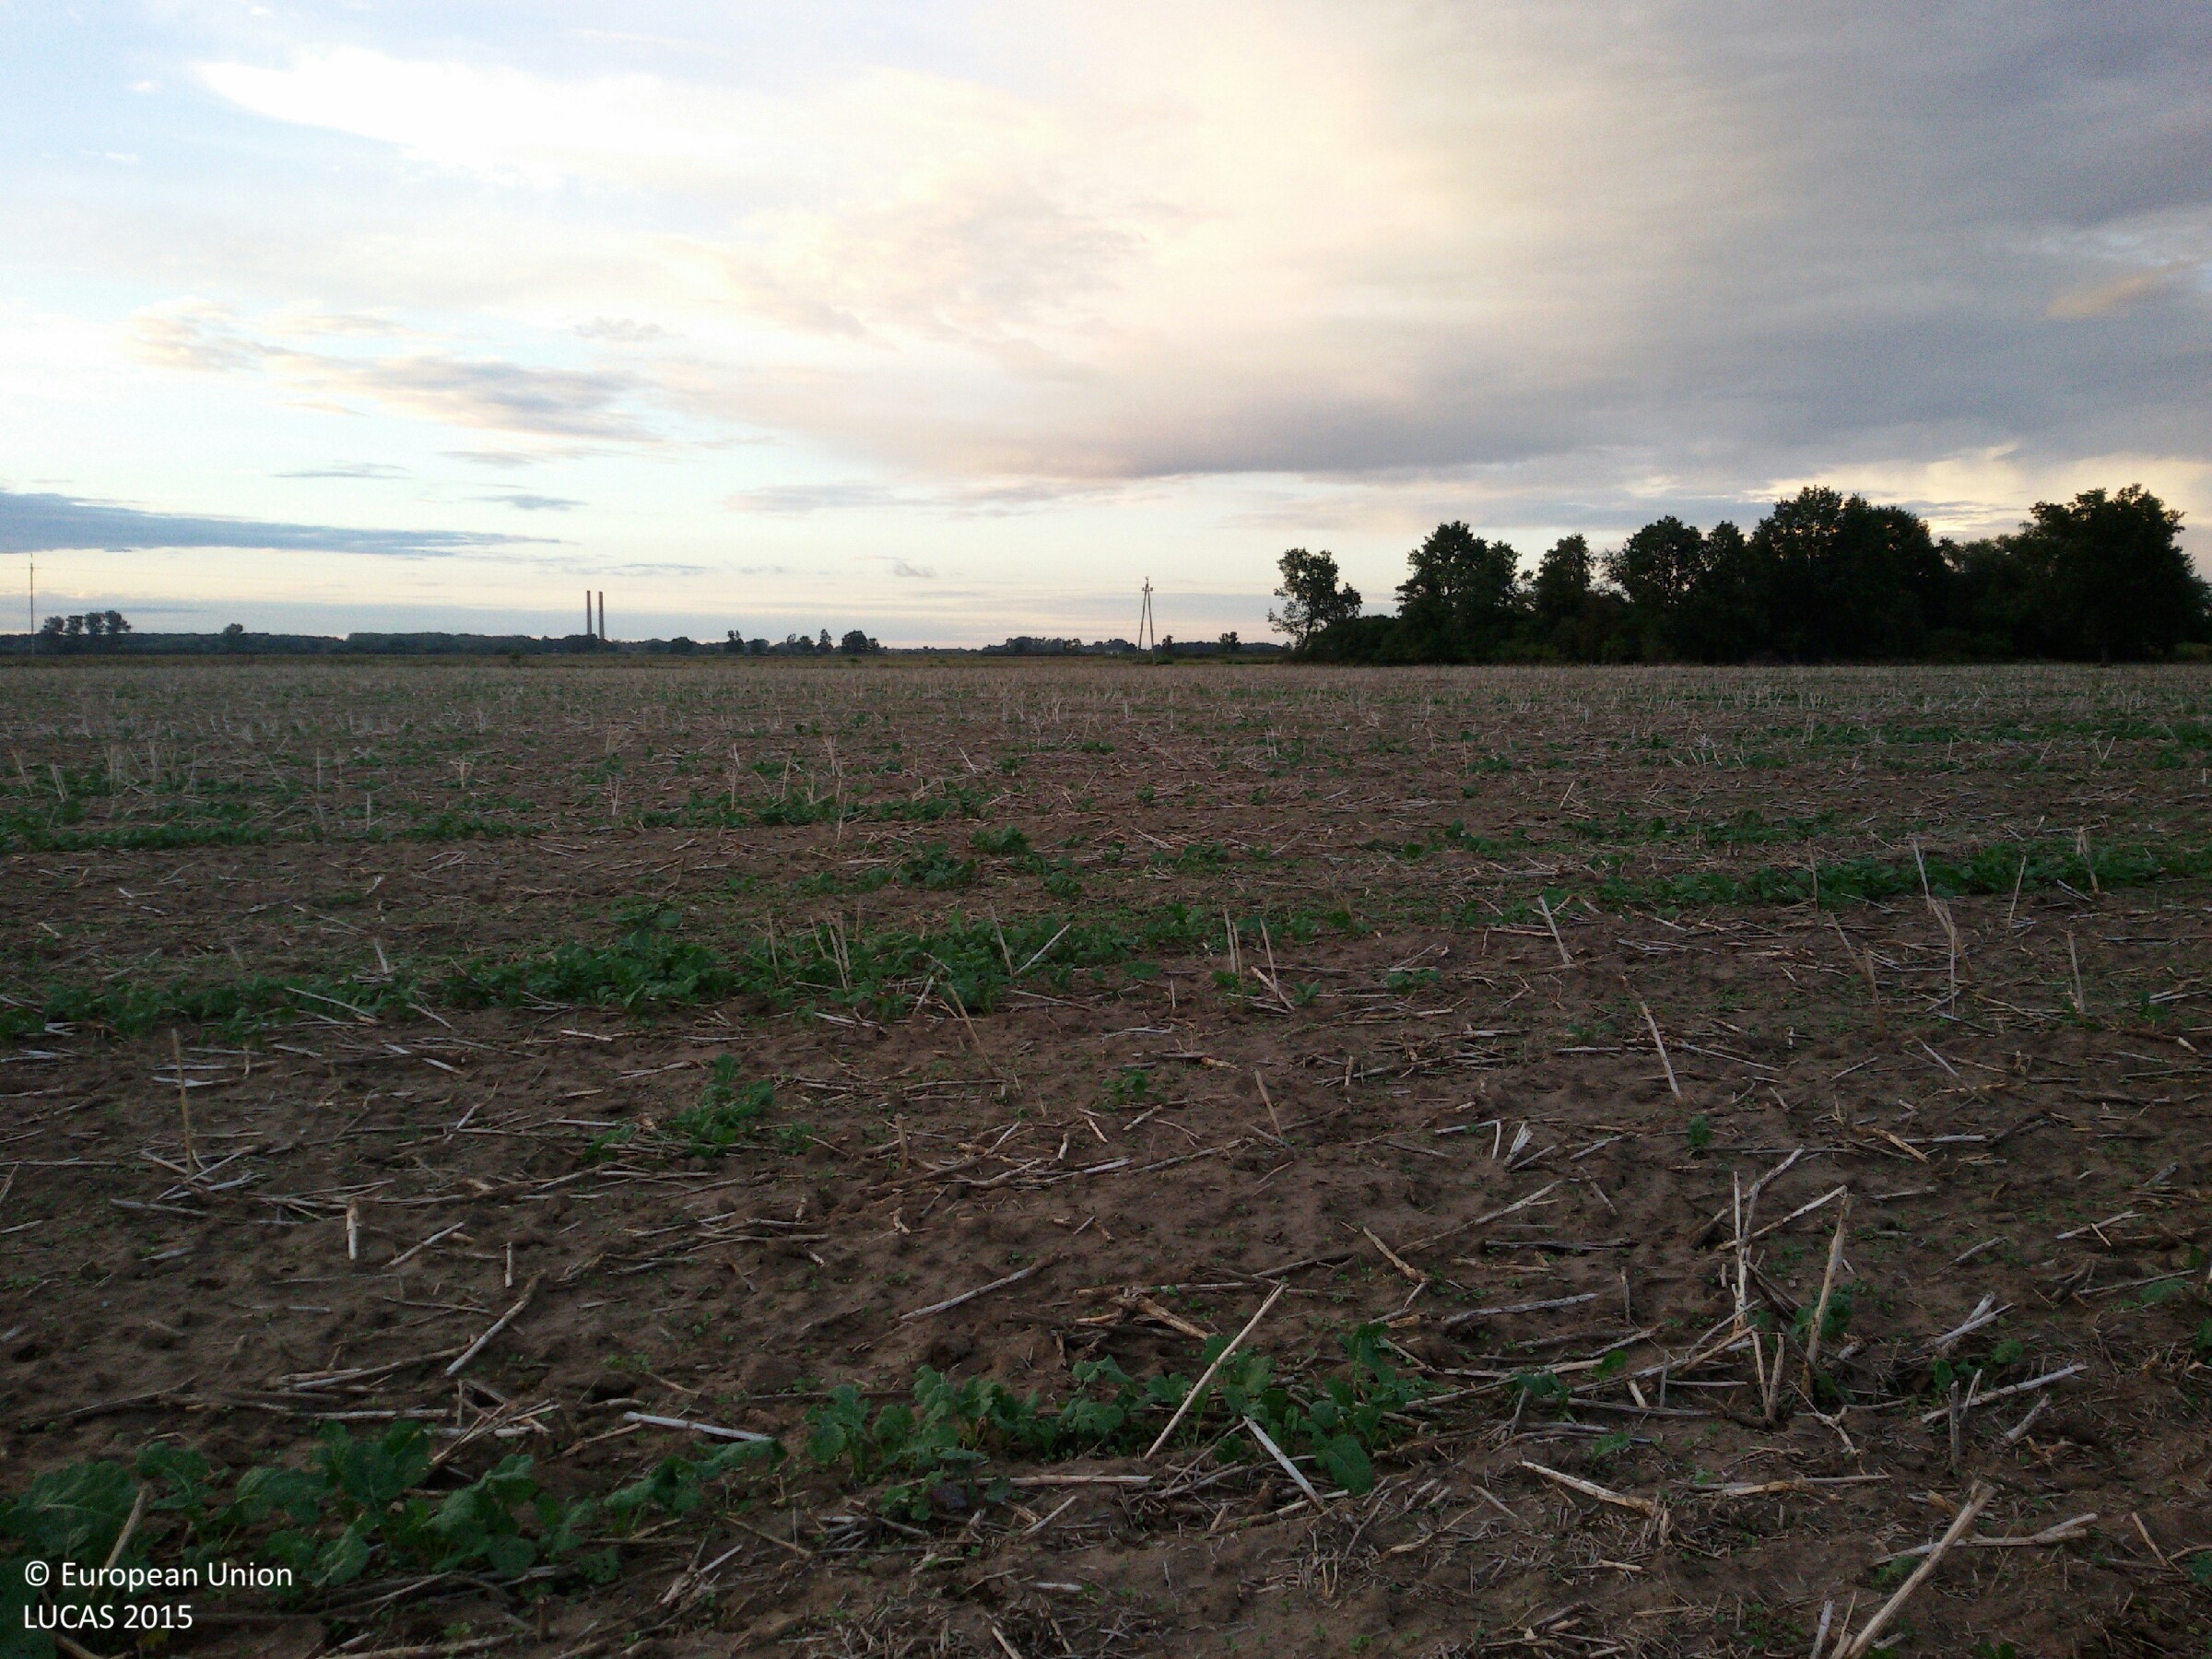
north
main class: Cropland
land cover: Rape and turnip rape
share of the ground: 10 - 25 %
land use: Agriculture (excluding fallow land and kitchen gardens)
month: September
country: PL
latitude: 52.1396
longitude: 14.7216
